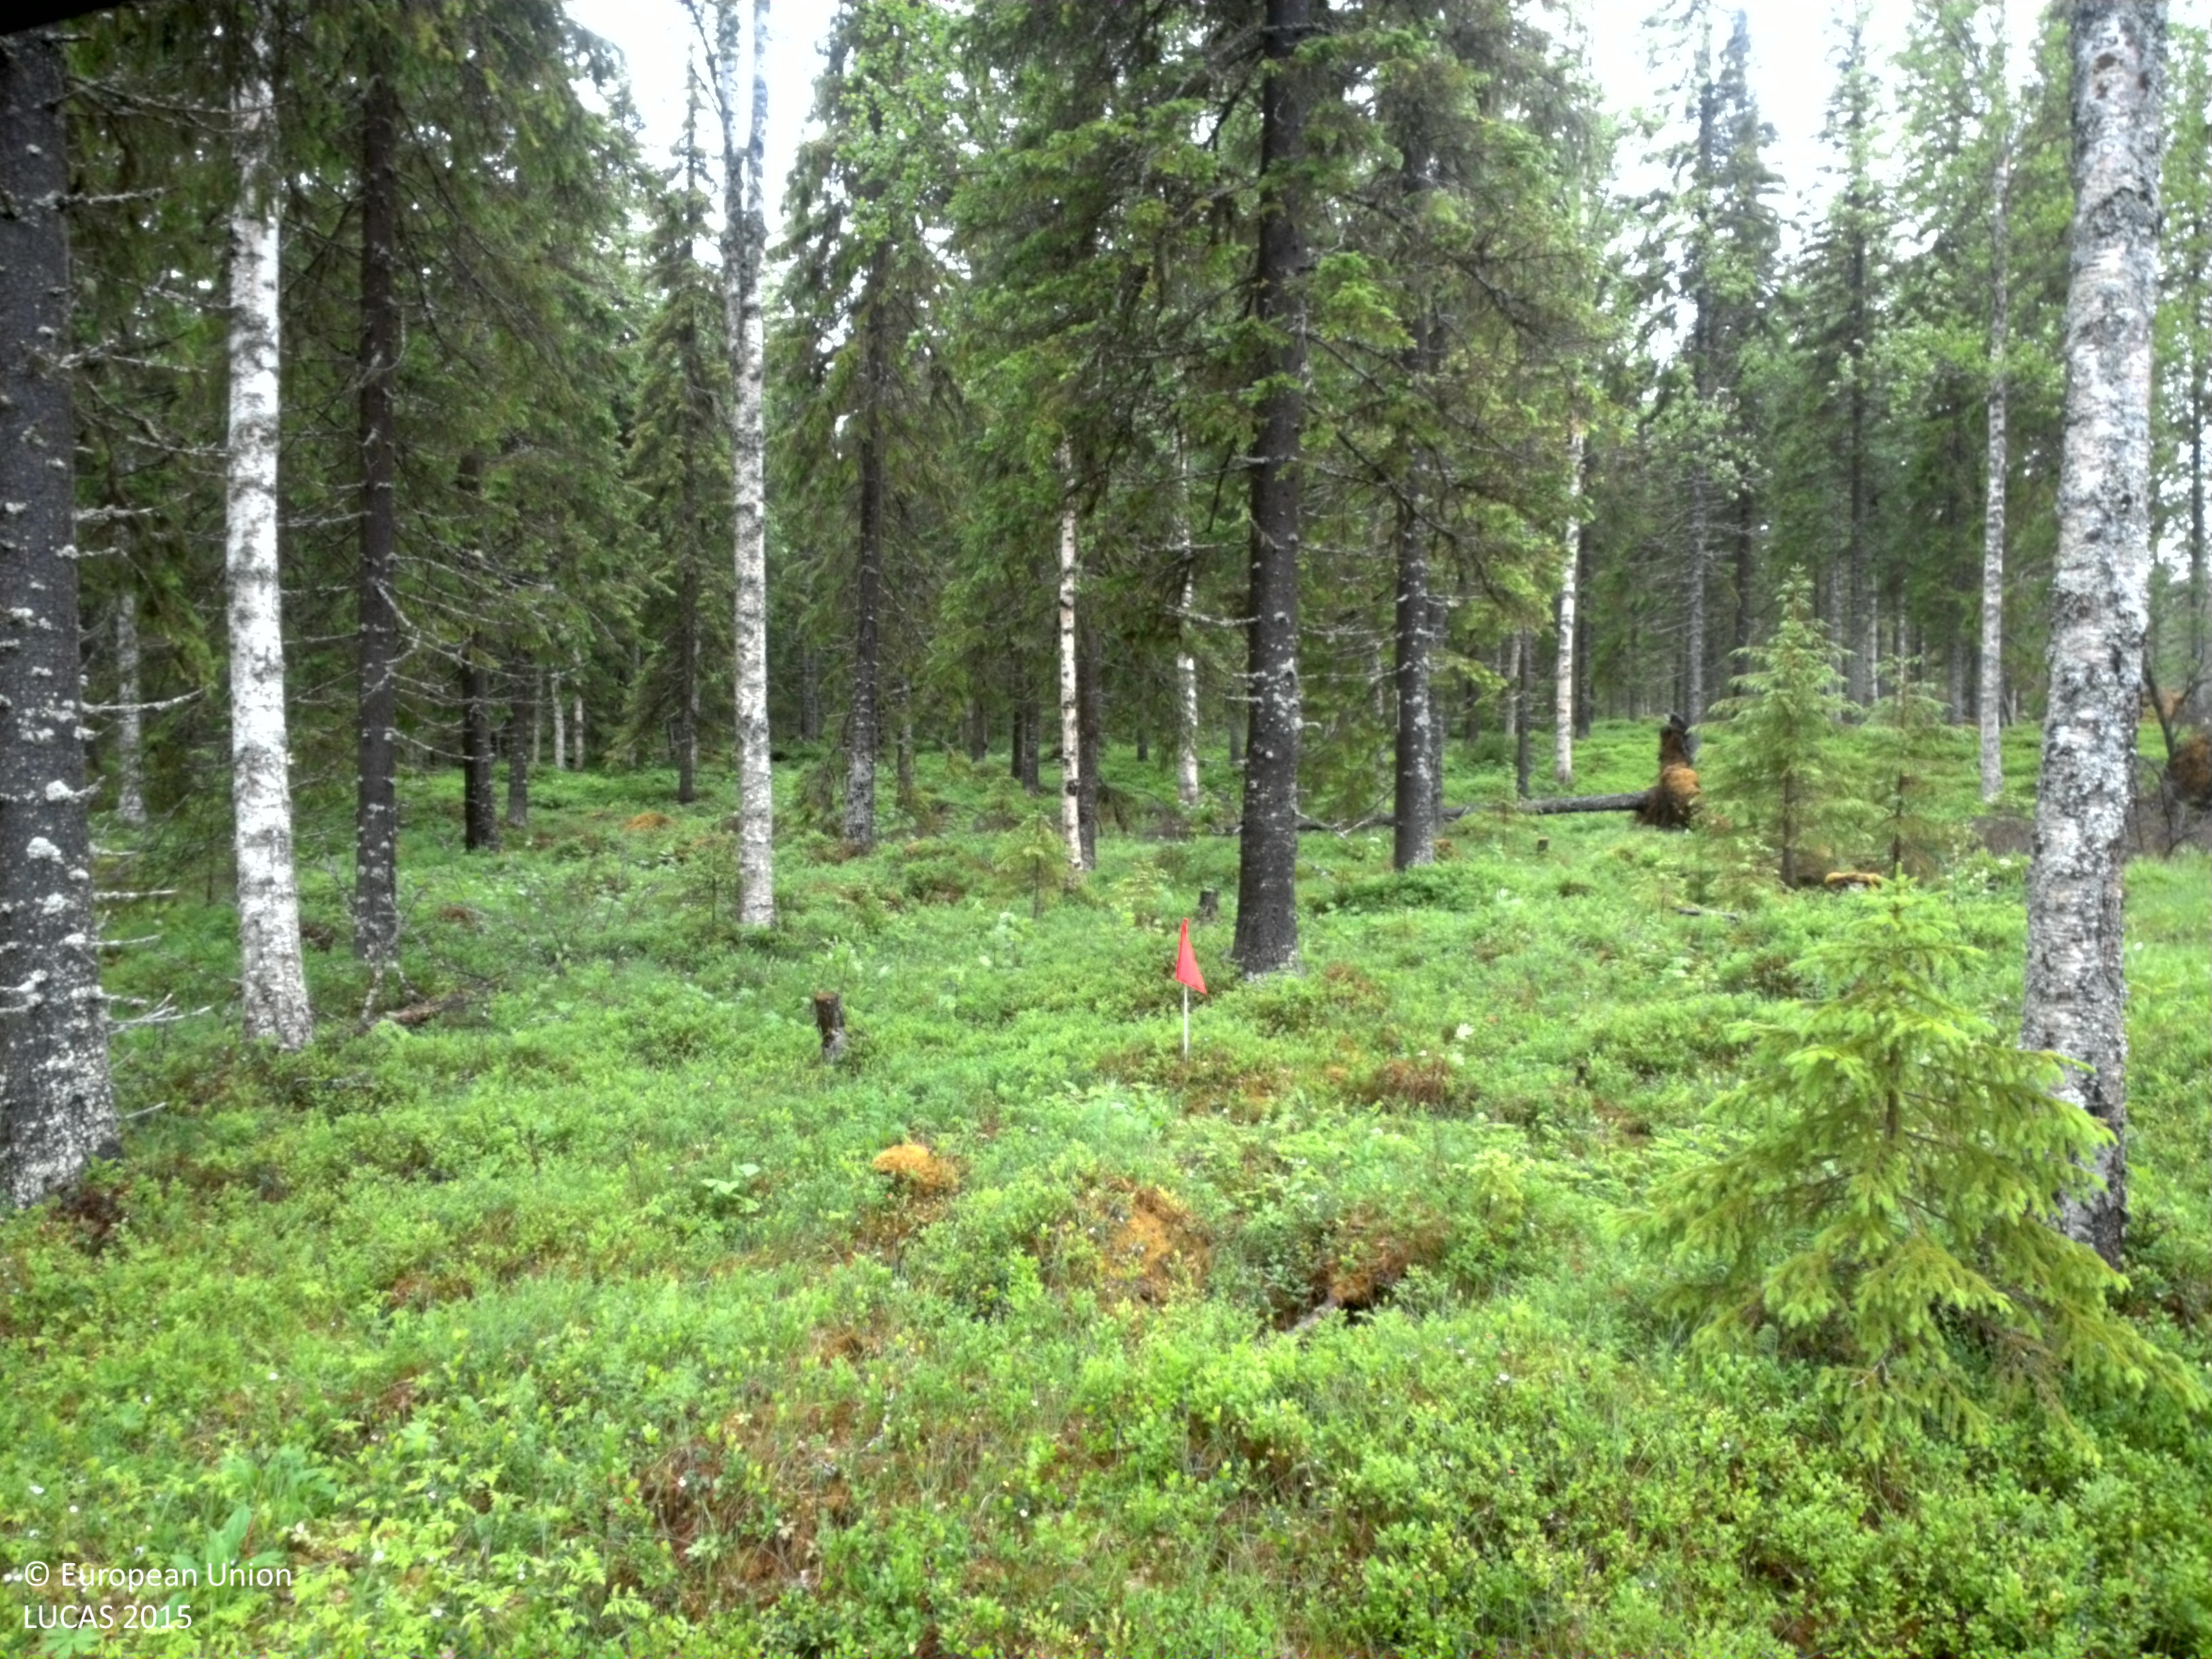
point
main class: Woodland
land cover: Spruce dominated mixed woodland
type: boreal forest
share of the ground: 50 - 75 %
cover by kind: coniferous forest trees 45 %, shrubs 35 %, broadleaved forest trees 15 %, herbaceous plants 5 %
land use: Forestry
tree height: > 5 m
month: July
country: SE
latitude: 64.5733
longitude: 18.0872
